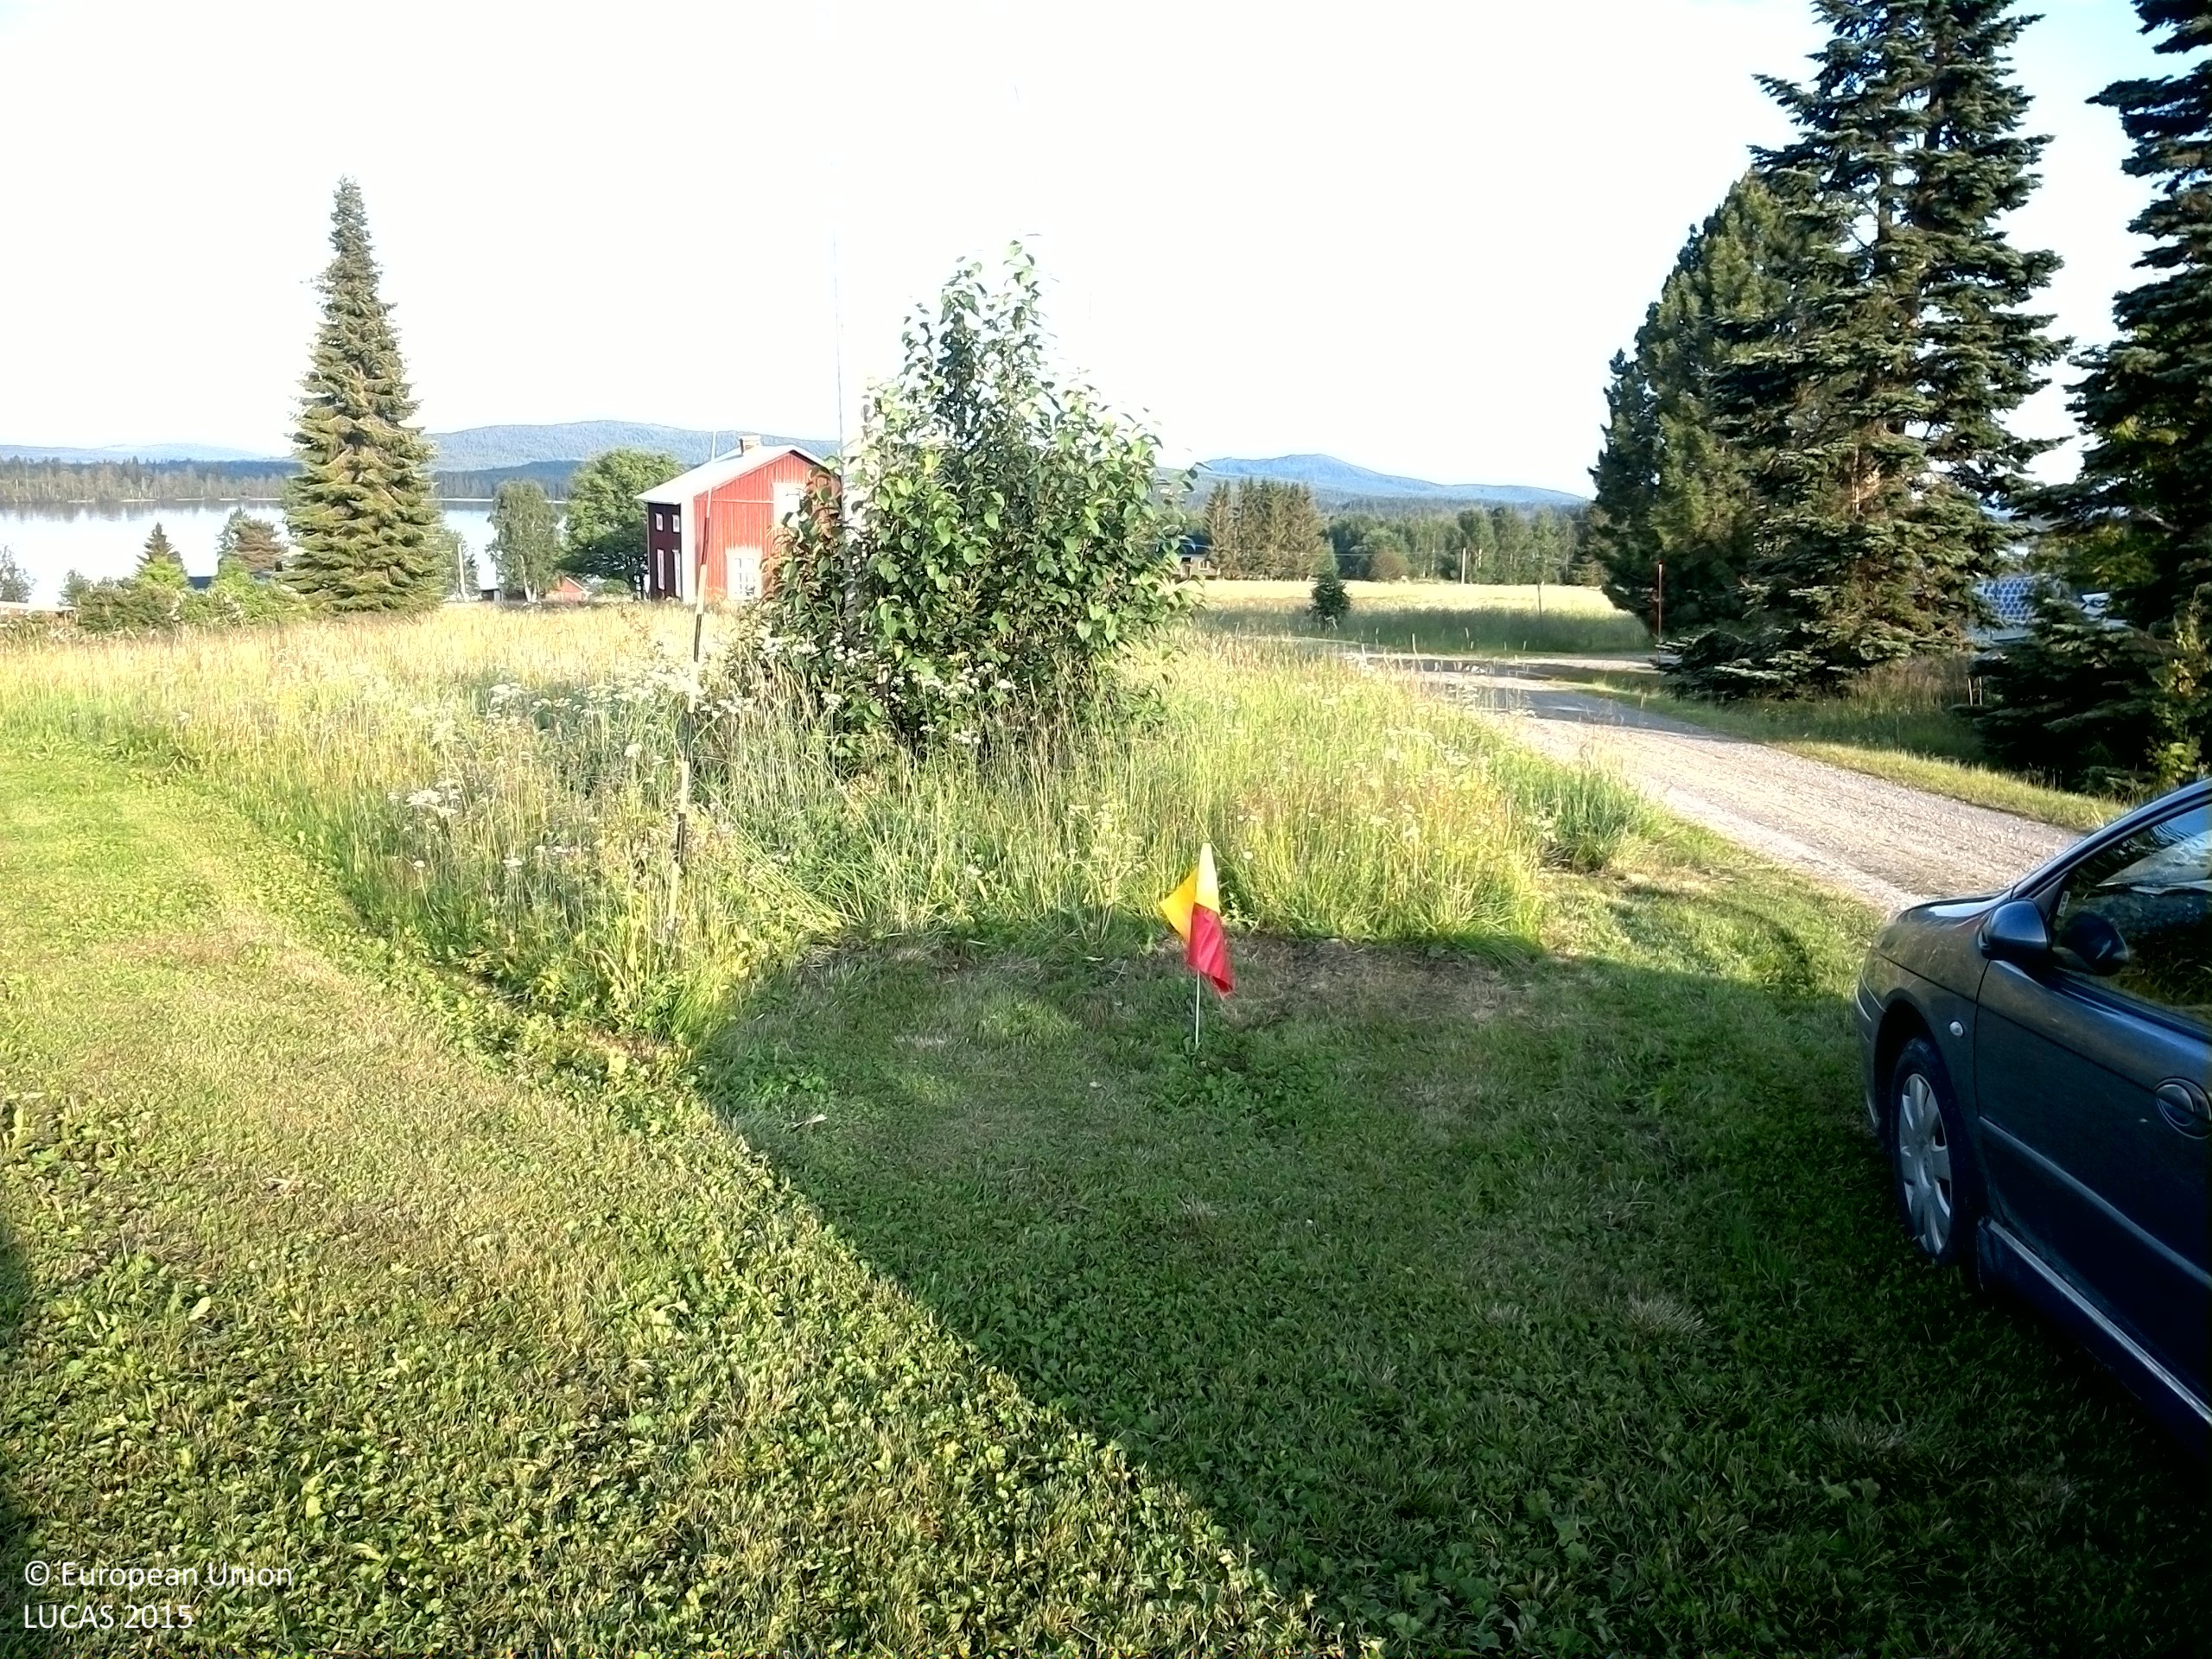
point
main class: Grassland
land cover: Grassland without tree/shrub cover
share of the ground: > 75 %
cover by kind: herbaceous plants 95 %, shrubs 5 %
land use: Residential
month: July
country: SE
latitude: 64.1859
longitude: 16.6590
